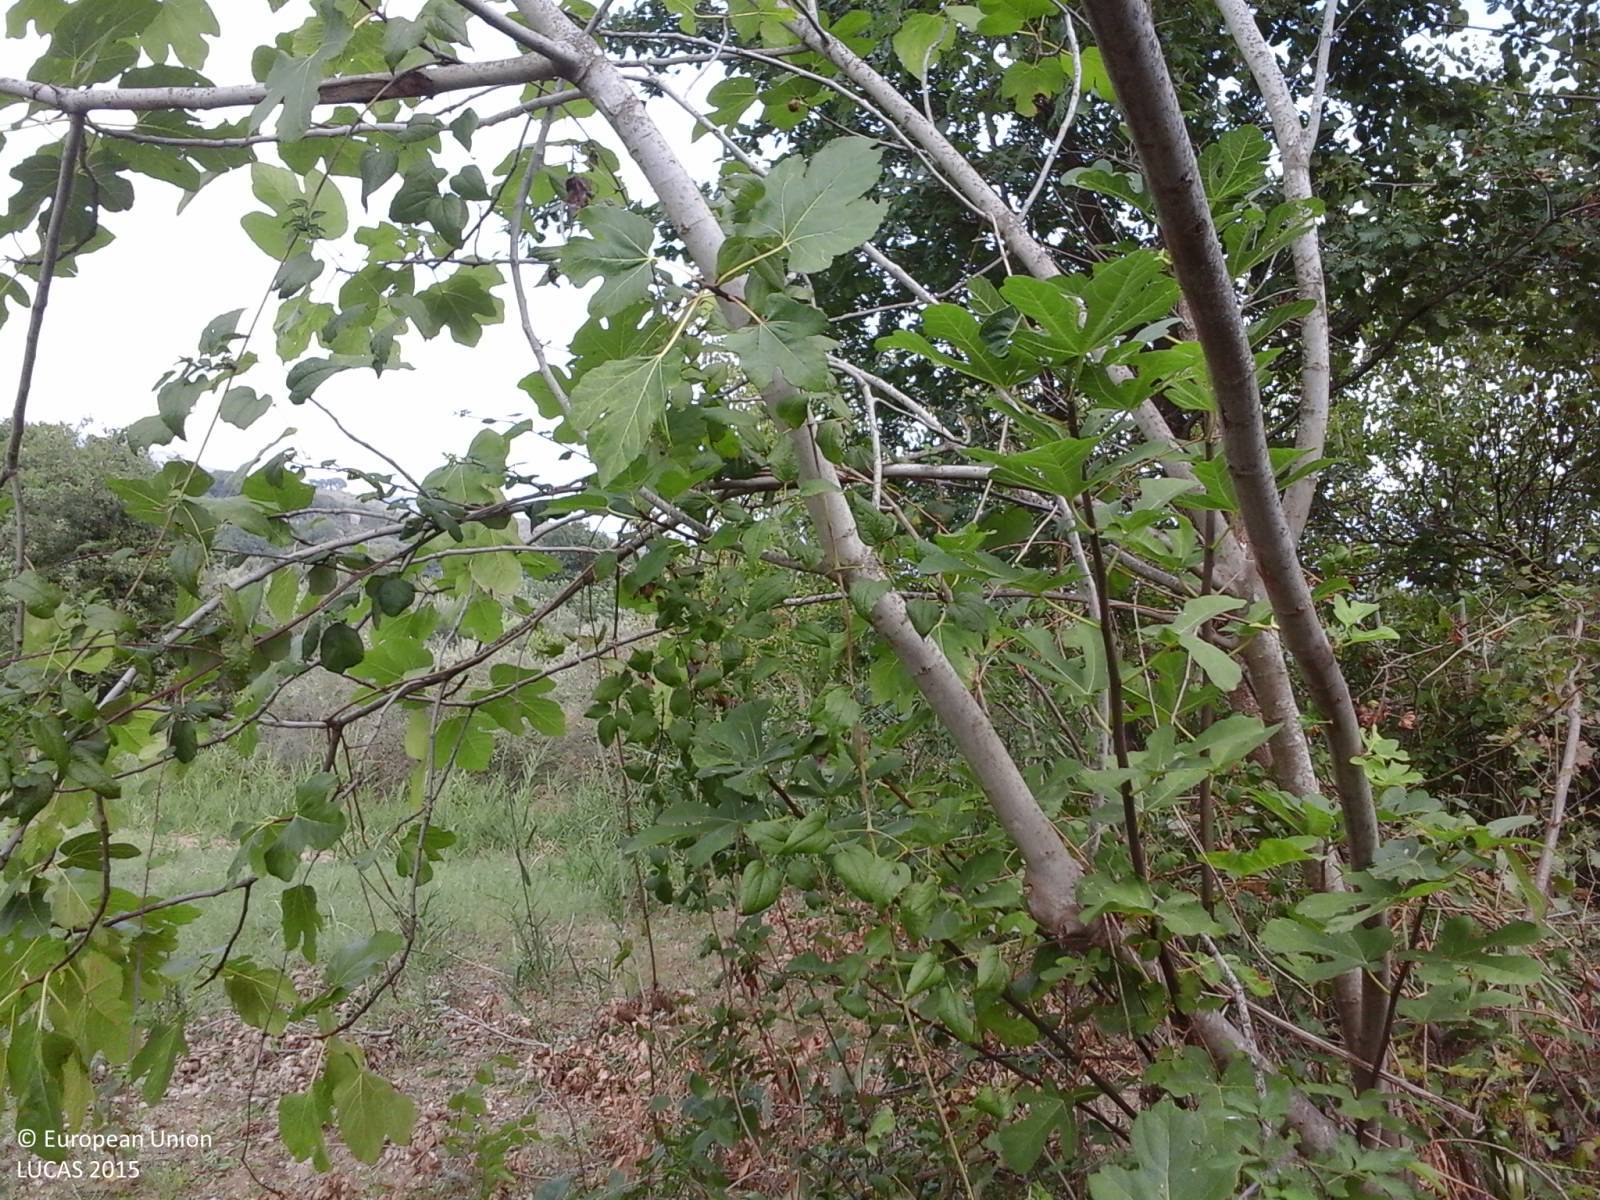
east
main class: Grassland
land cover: Spontaneously vegetated surfaces
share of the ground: > 75 %
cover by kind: herbaceous plants 100 %
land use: Agriculture (excluding fallow land and kitchen gardens)
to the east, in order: Spontaneously vegetated surfaces; Single bushes/trees; Fences; Broadleaved woodland; Ditches and canals; Olive groves; Ditches and canals; Olive groves; Fences; Olive groves; Fences; Olive groves; Ditches and canals; Broadleaved woodland
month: September
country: IT
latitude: 41.2634
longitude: 13.7688
